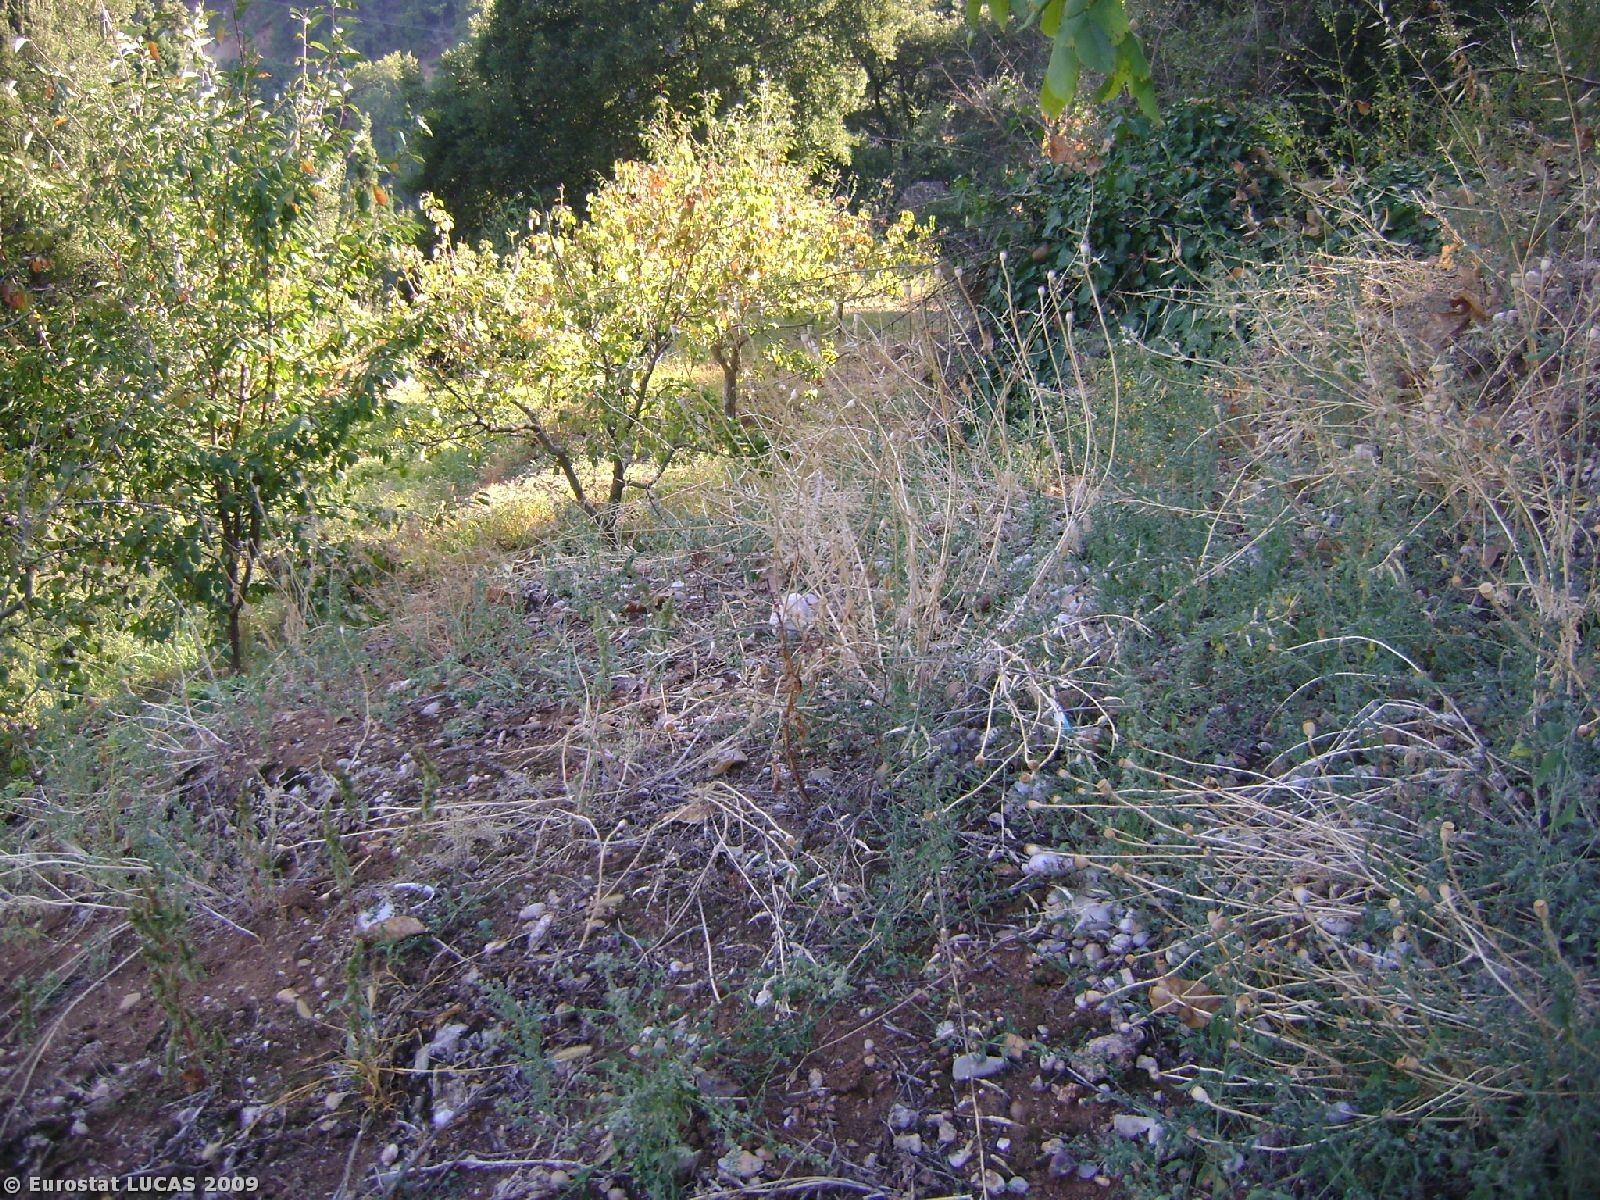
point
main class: Grassland
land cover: Grassland without tree/shrub cover
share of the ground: > 75 %
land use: Unused
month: October
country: GR
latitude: 38.0973
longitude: 22.3190
